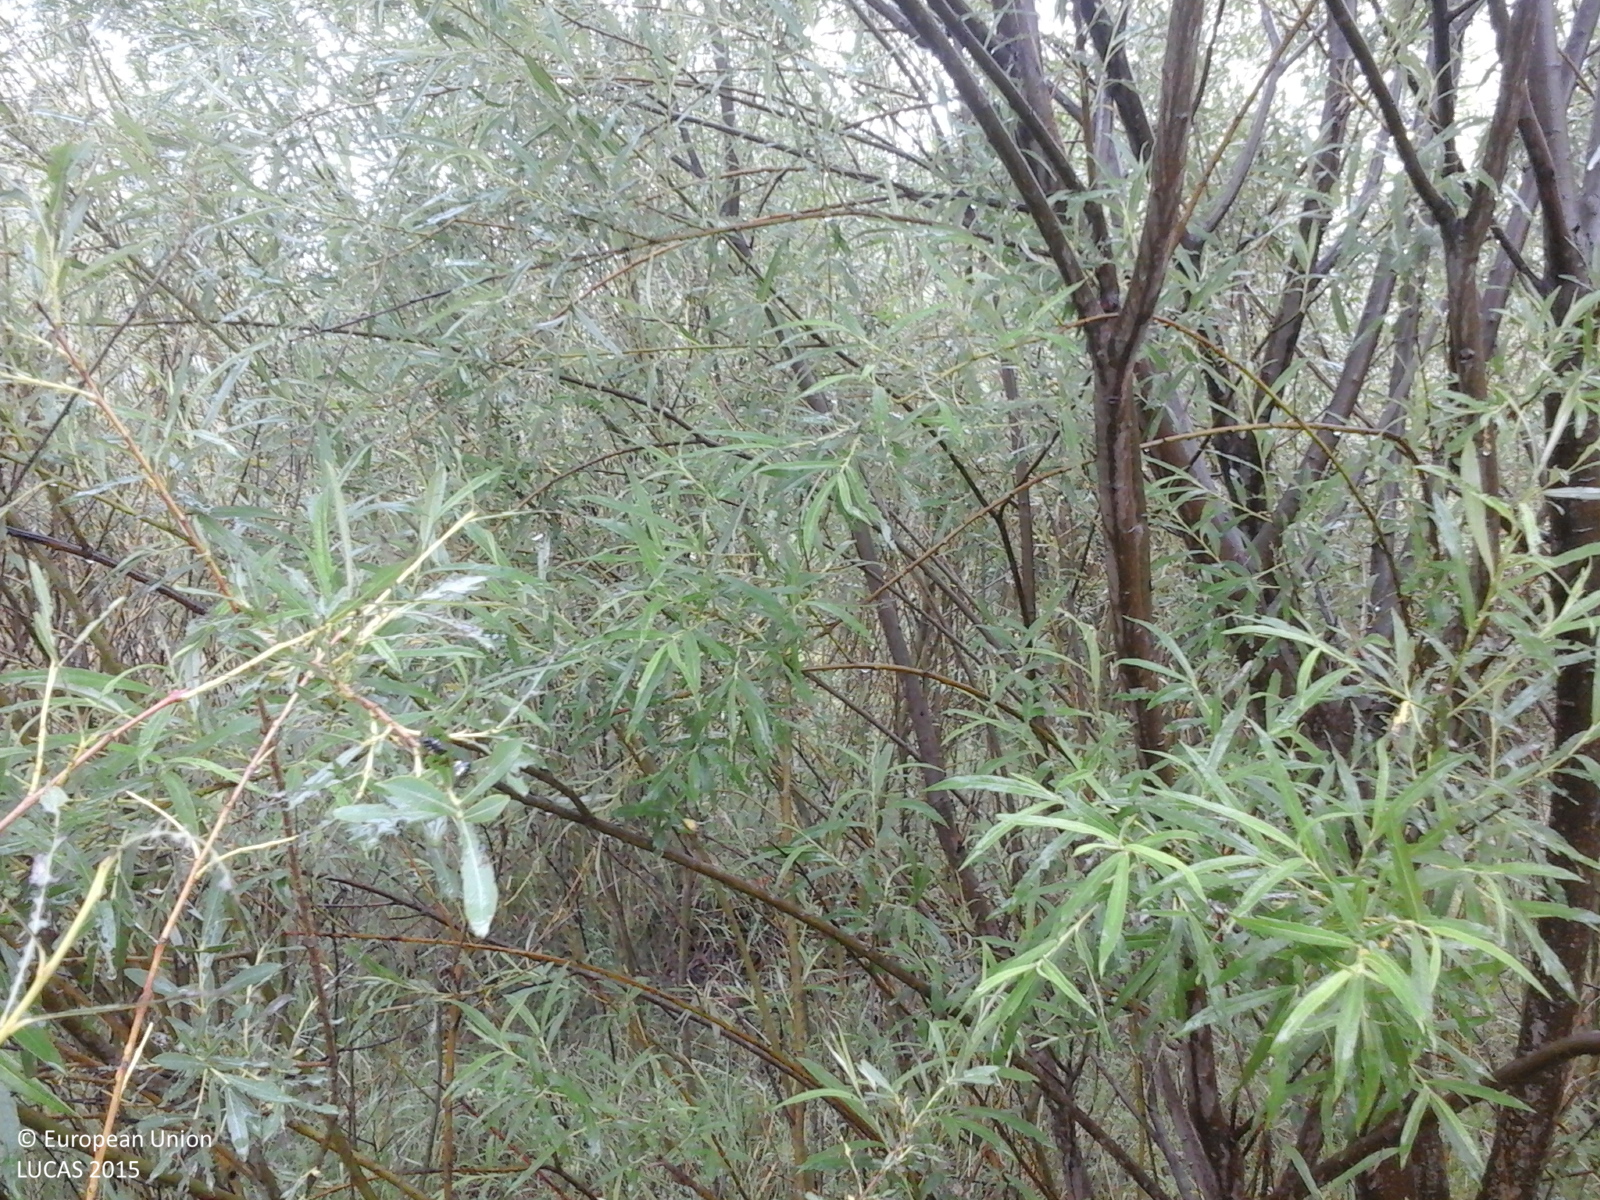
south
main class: Shrubland
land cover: Shrubland without tree cover
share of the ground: 50 - 75 %
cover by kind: shrubs 75 %, herbaceous plants 25 %
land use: Semi-natural and natural areas not in use
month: June
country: RO
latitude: 47.3542
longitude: 26.3815
